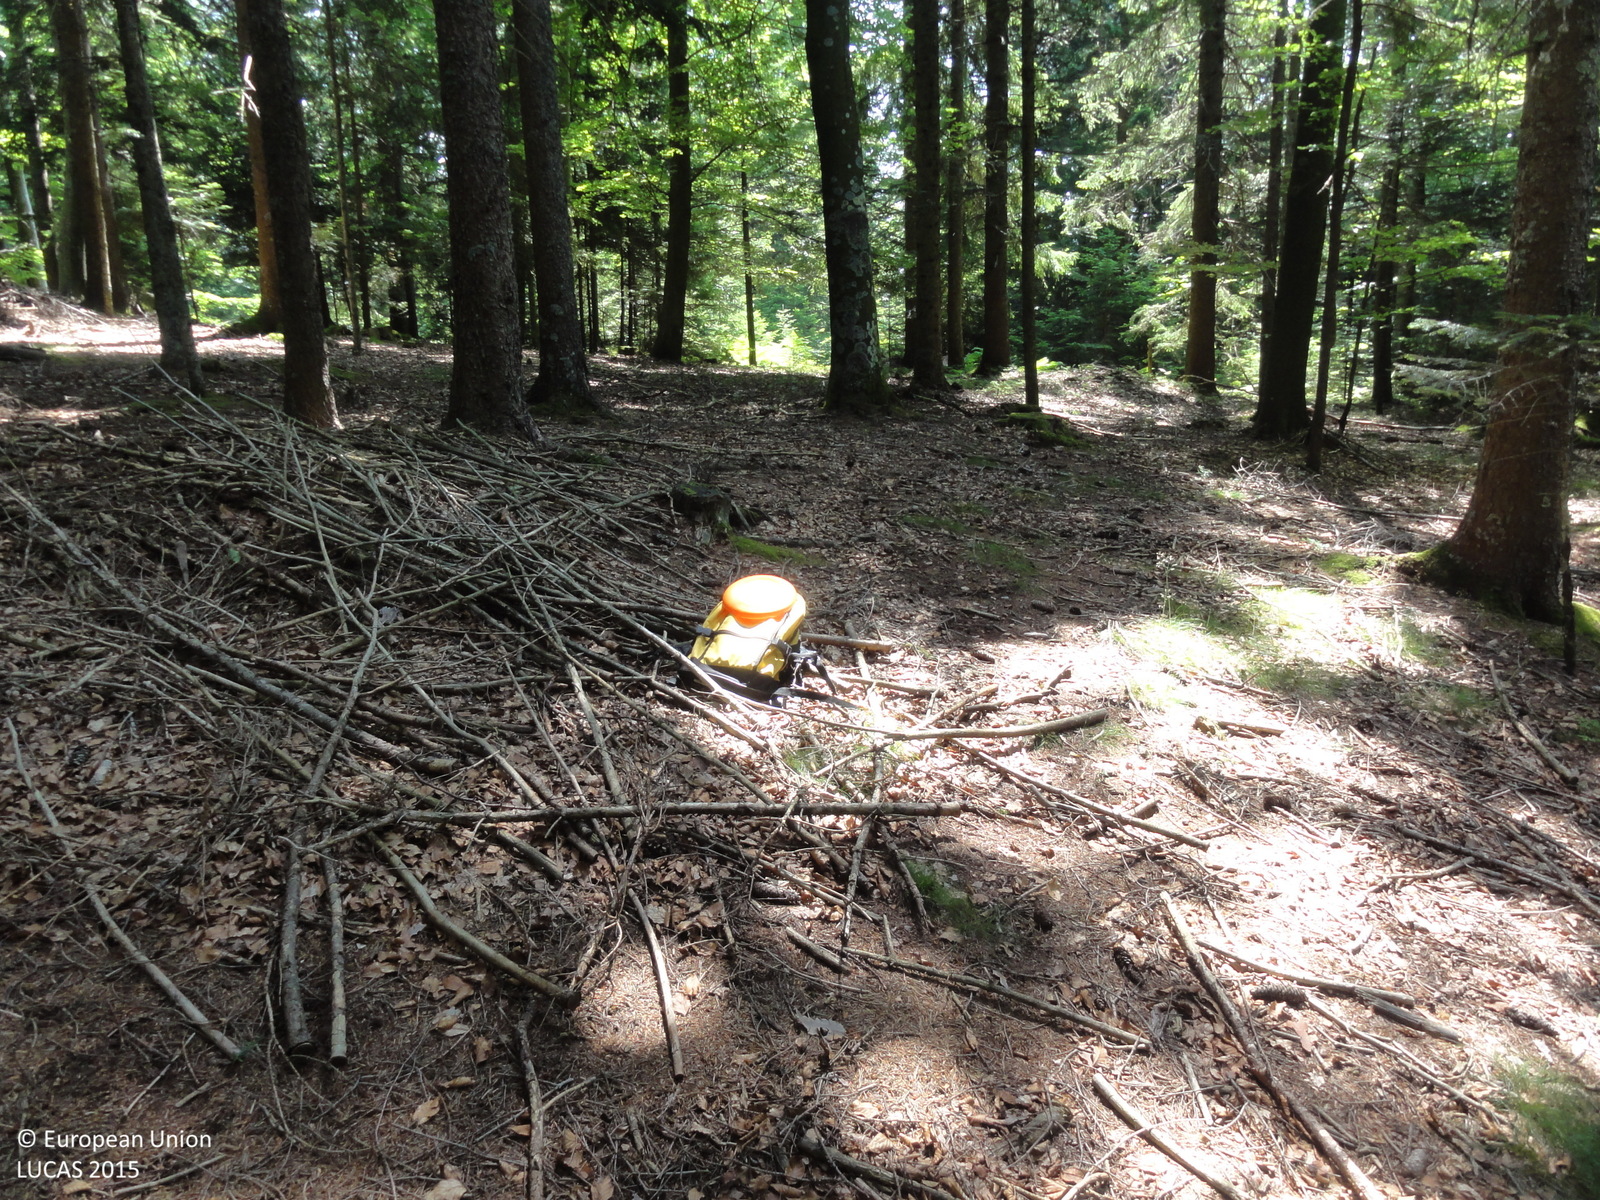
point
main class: Woodland
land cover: Spruce dominated coniferous woodland
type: hemiboreal forest and nemoral coniferous forest and mixed broadleaved-coniferous forest
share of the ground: > 75 %
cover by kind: coniferous forest trees 85 %, broadleaved forest trees 15 %
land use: Forestry
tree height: > 5 m
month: July
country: SI
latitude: 46.4634
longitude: 15.4806
